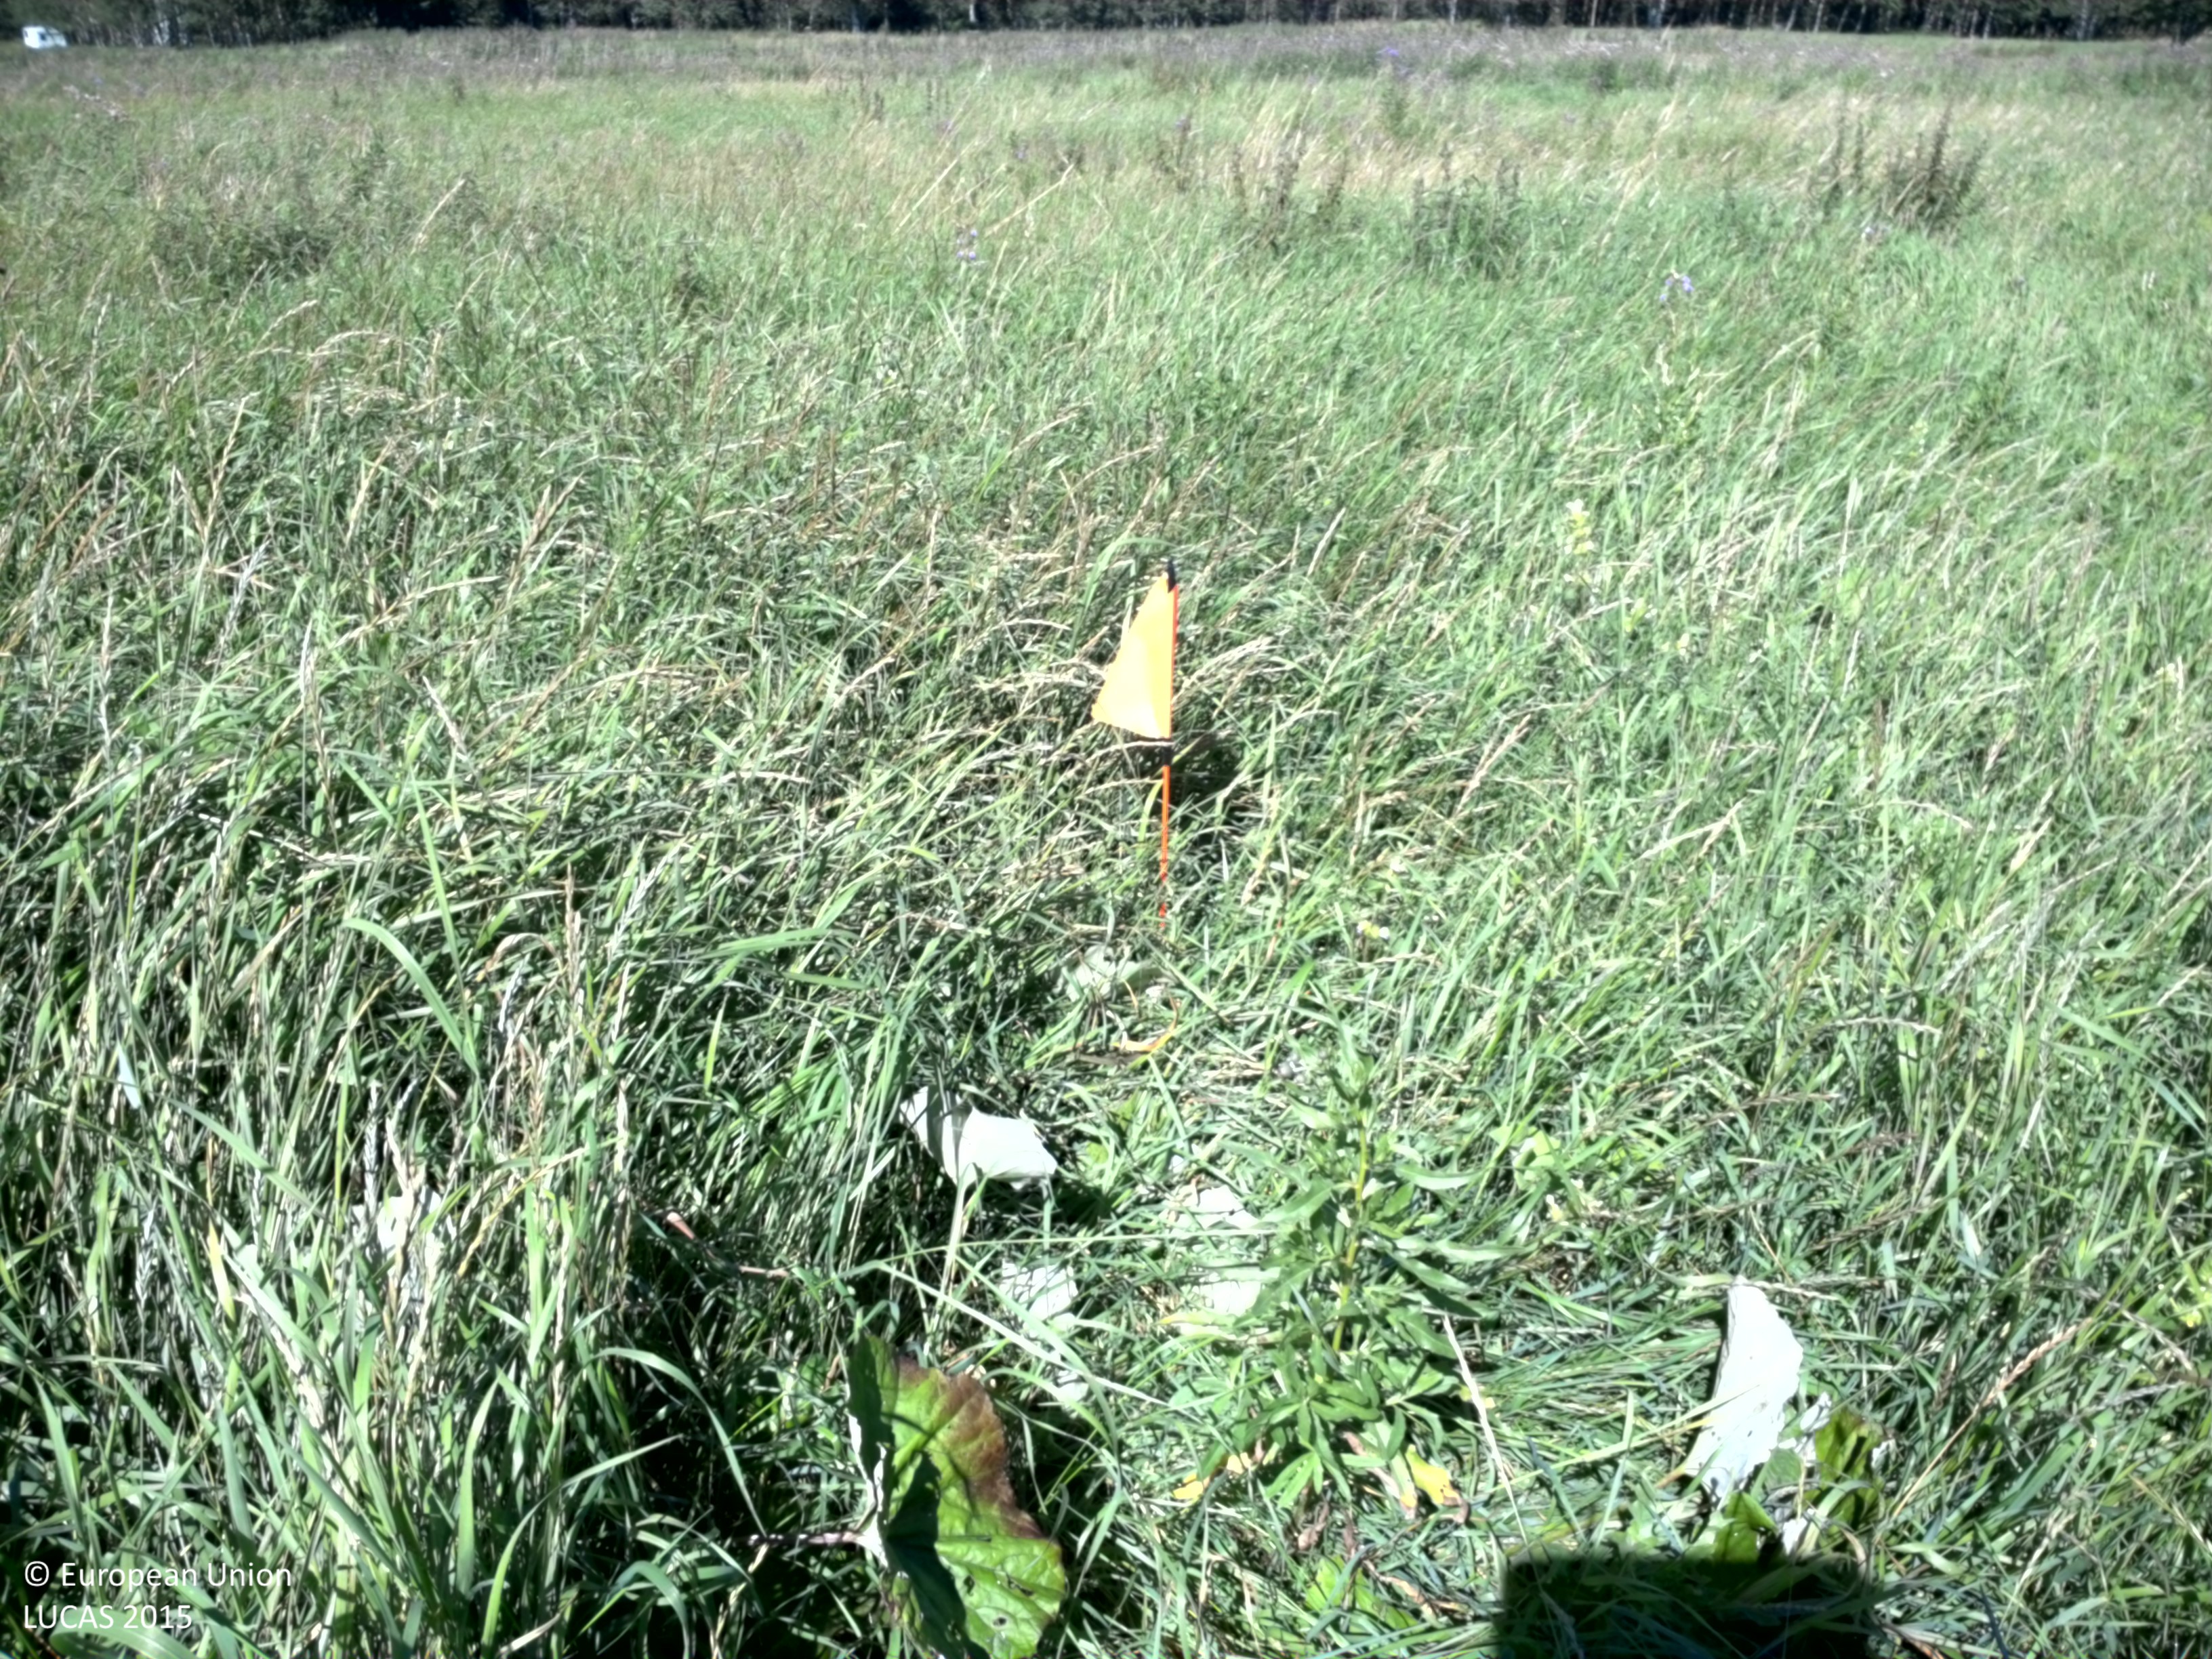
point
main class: Grassland
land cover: Grassland without tree/shrub cover
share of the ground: > 75 %
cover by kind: herbaceous plants 100 %
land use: Semi-natural and natural areas not in use
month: August
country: SE
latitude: 60.1265
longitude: 17.1371
